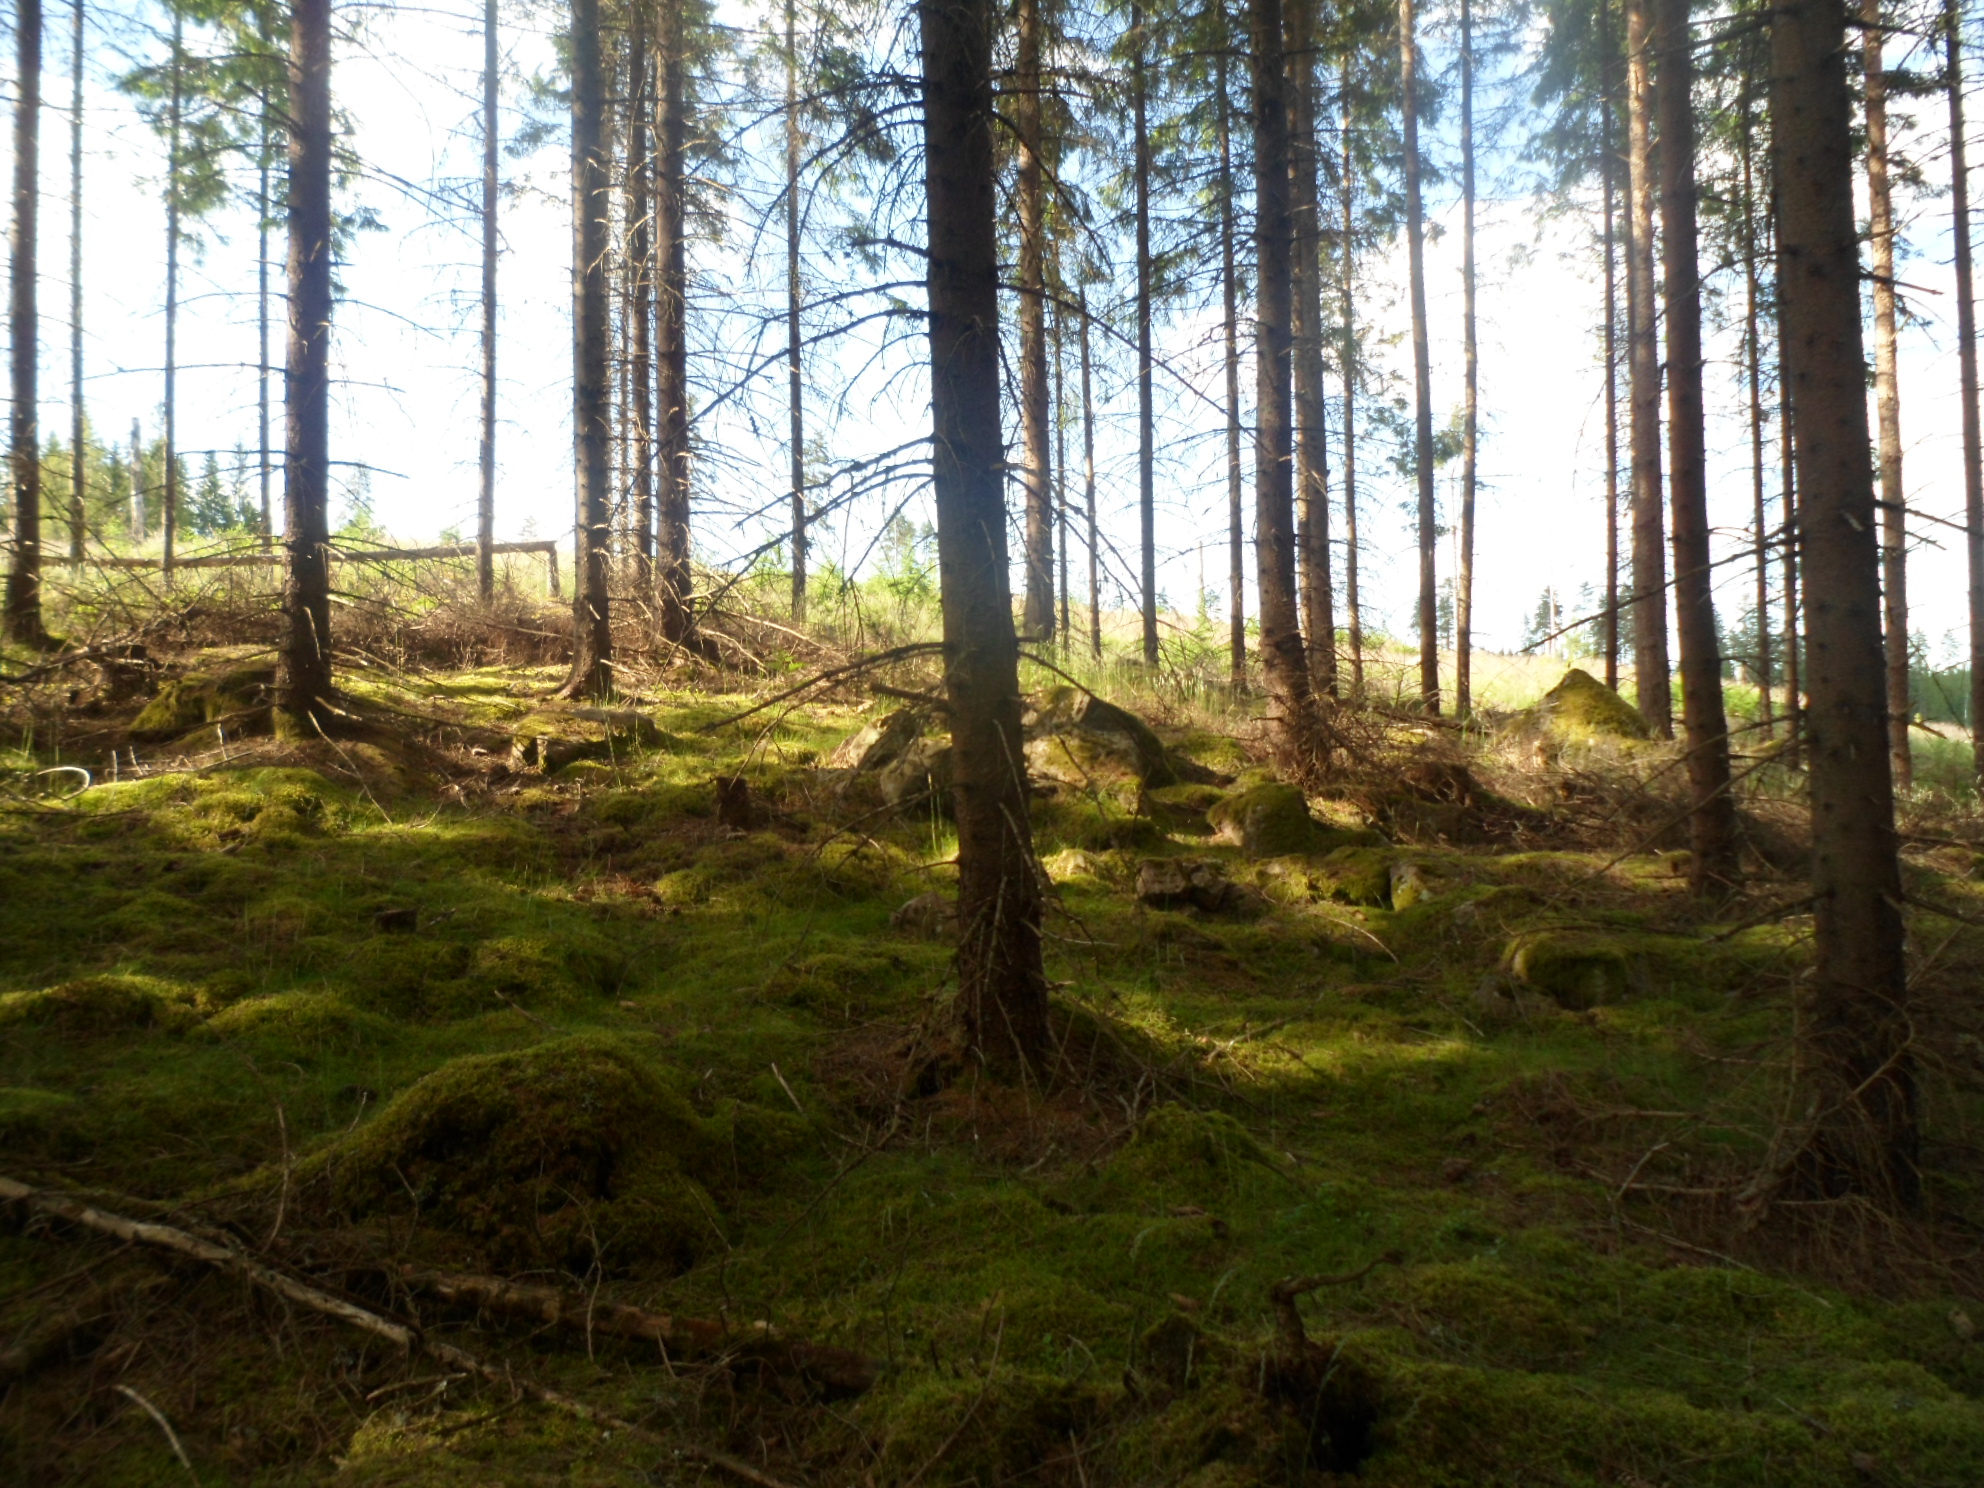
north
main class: Woodland
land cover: Spruce dominated coniferous woodland
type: boreal forest
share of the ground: 50 - 75 %
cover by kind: coniferous forest trees 60 %, lichens and mosses 25 %, herbaceous plants 15 %
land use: Forestry
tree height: > 5 m
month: July
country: SE
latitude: 57.5545
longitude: 14.3574
